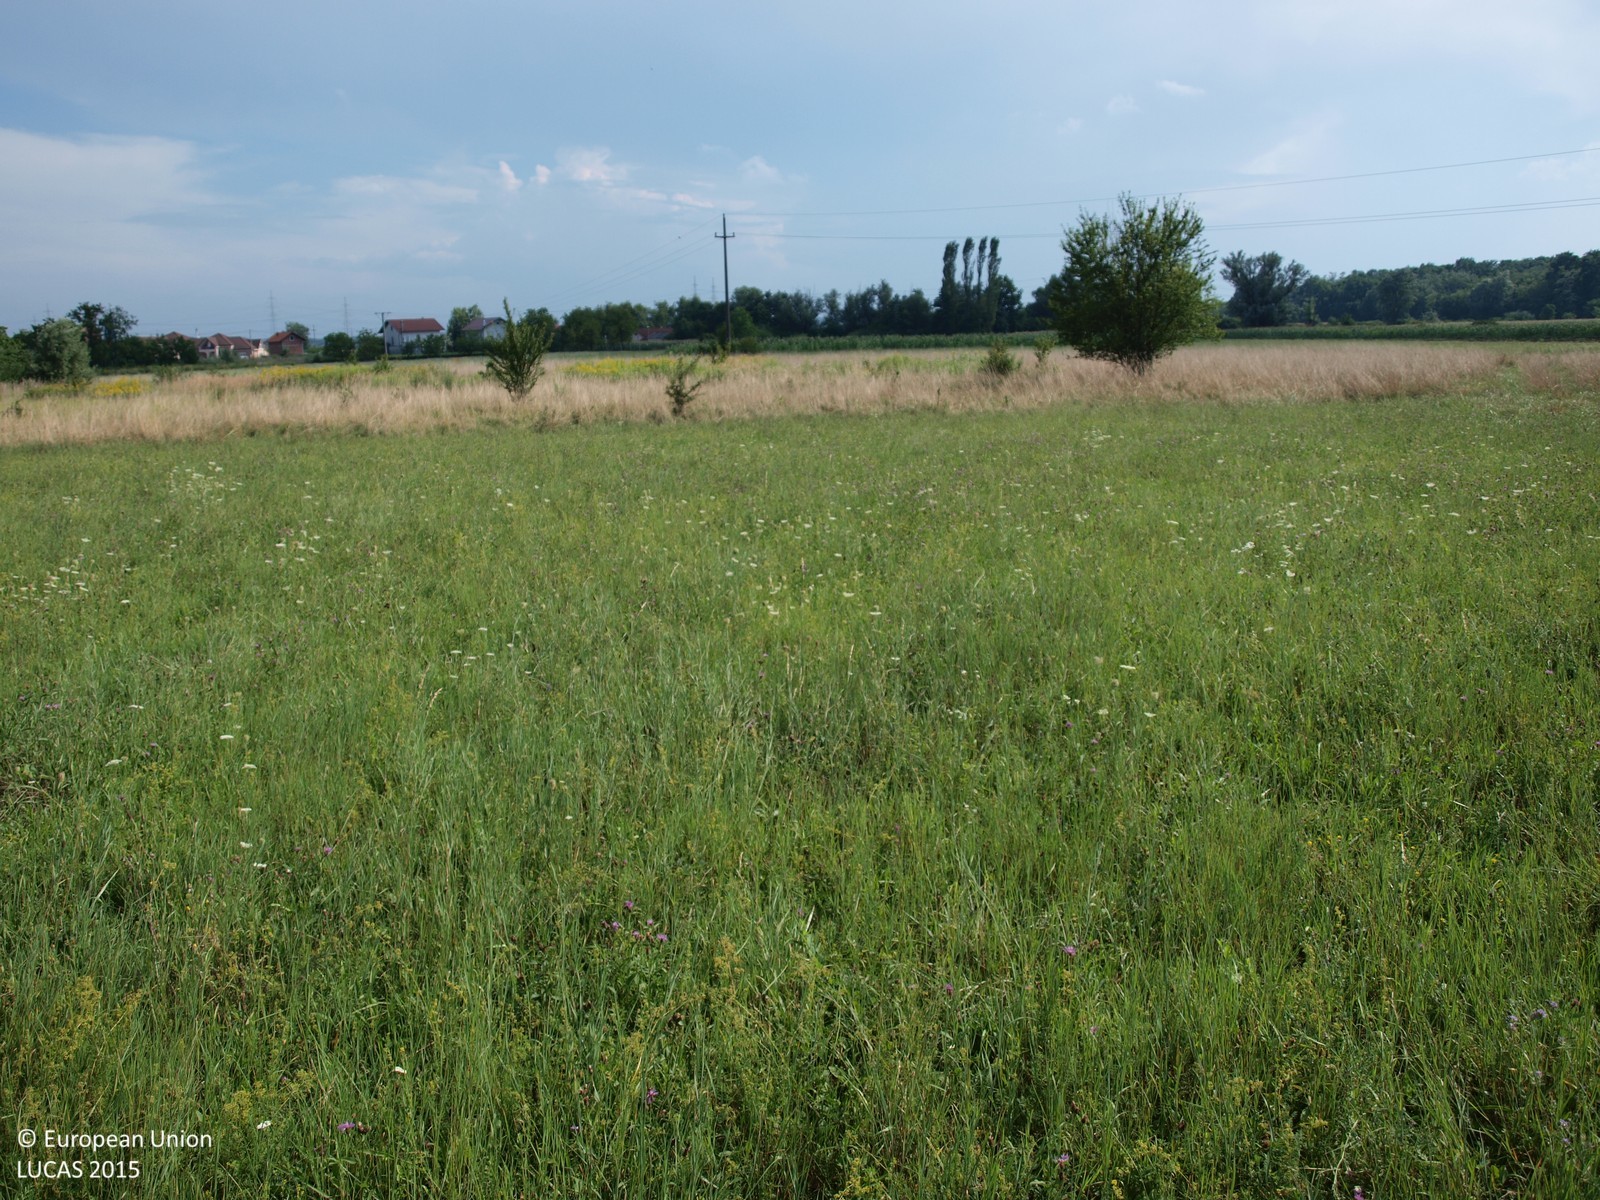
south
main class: Grassland
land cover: Grassland without tree/shrub cover
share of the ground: > 75 %
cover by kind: herbaceous plants 100 %
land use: Agriculture (excluding fallow land and kitchen gardens)
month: August
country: HR
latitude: 45.8840
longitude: 16.1707
